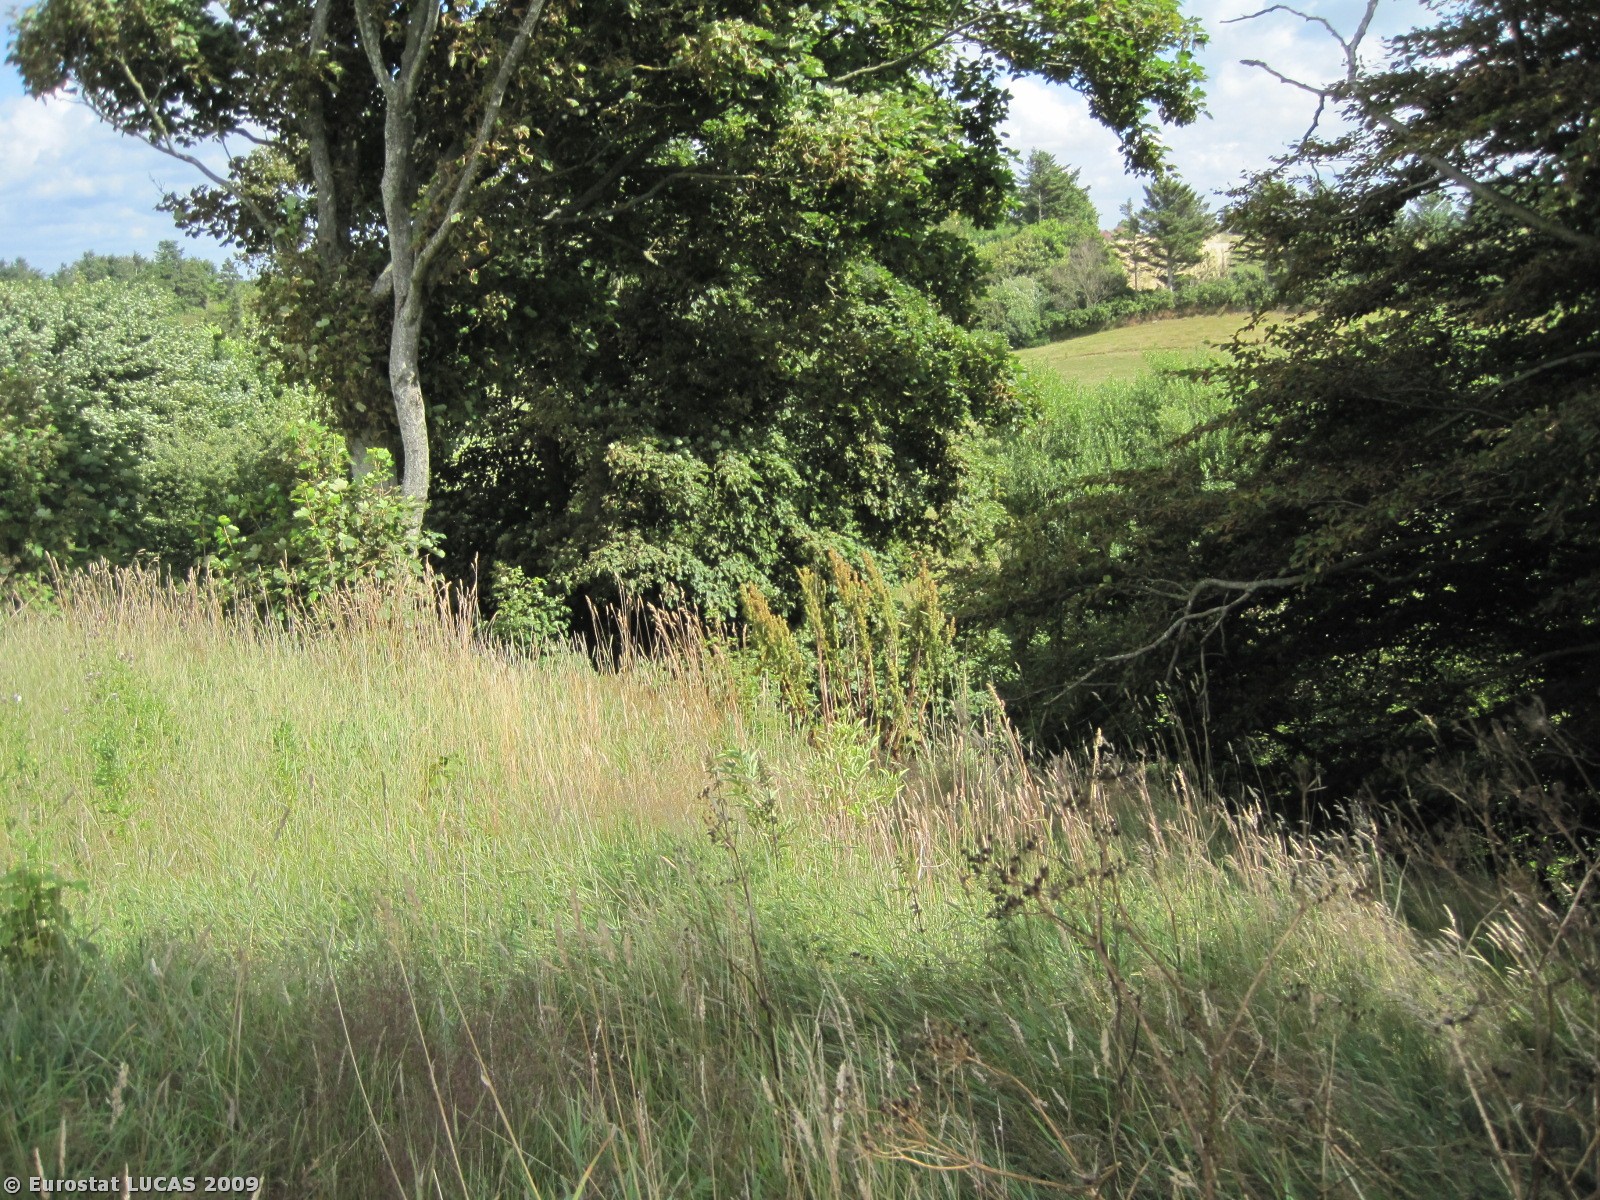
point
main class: Grassland
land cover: Grassland with sparse tree/shrub cover
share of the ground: > 75 %
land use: Unused
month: July
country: DK
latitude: 56.8620
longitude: 8.4767
